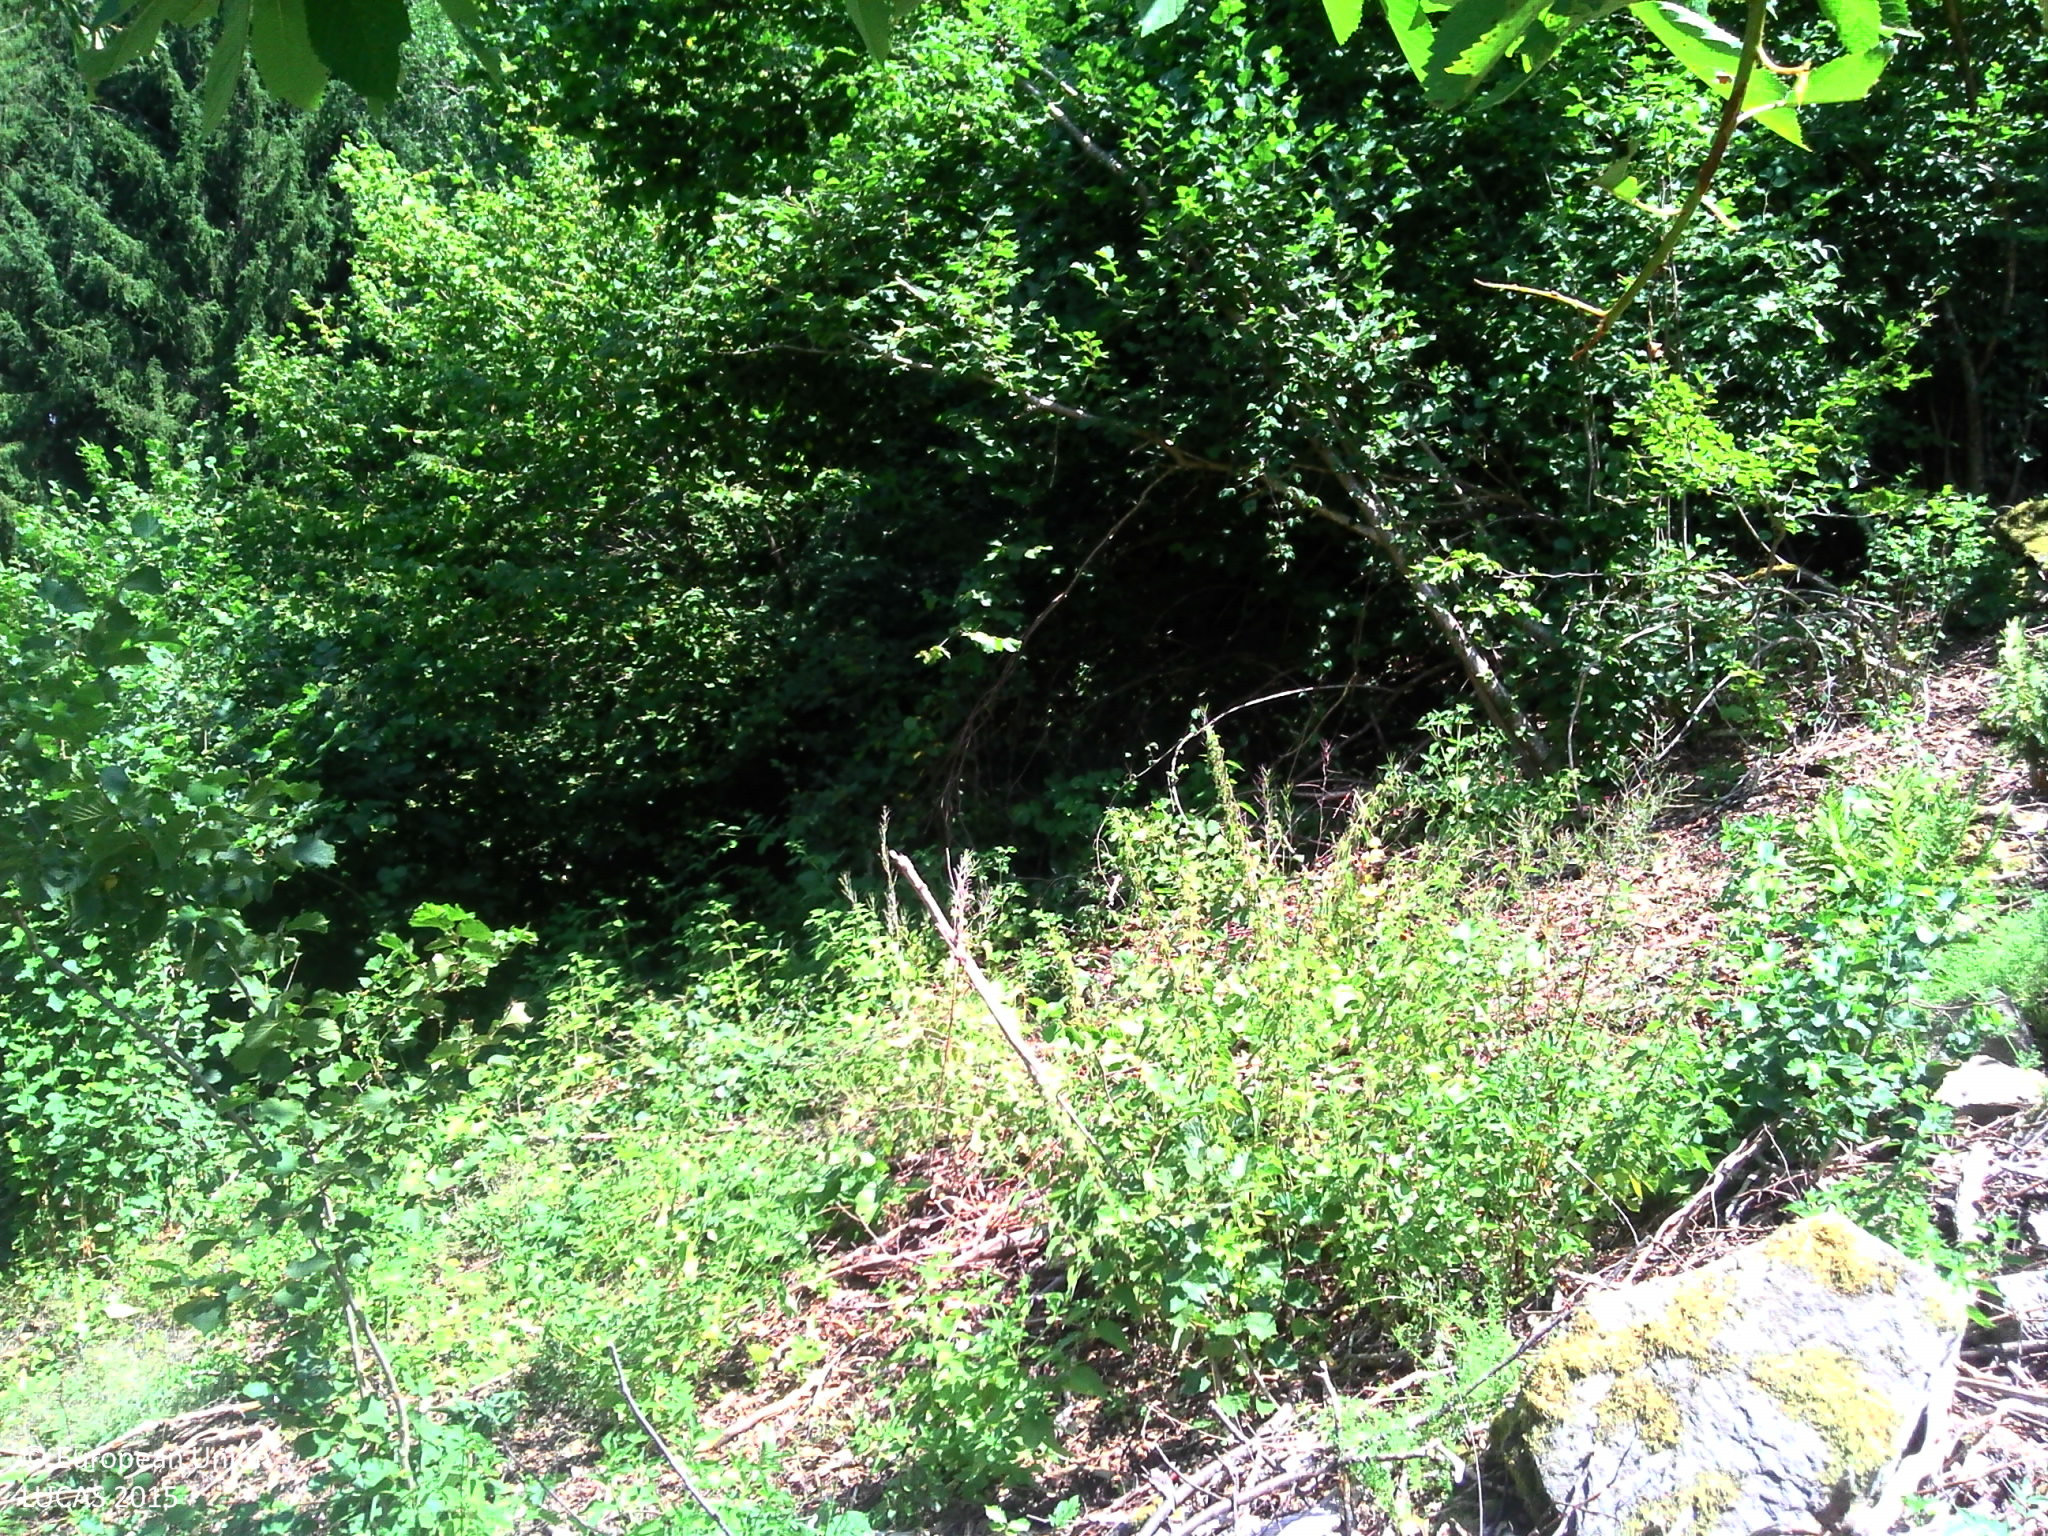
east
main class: Shrubland
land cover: Shrubland with sparse tree cover
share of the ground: > 75 %
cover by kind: shrubs 60 %, unconsolidated bare surface 20 %, herbaceous plants 15 %, broadleaved forest trees 5 %
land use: Forestry
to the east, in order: Shrubland with sparse tree cover; Broadleaved woodland; Fences; Grassland without tree/shrub cover; Fences; Broadleaved woodland; Rock outcrops; Broadleaved woodland; Spruce dominated mixed woodland
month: July
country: FR
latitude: 45.1022
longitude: 2.8974
